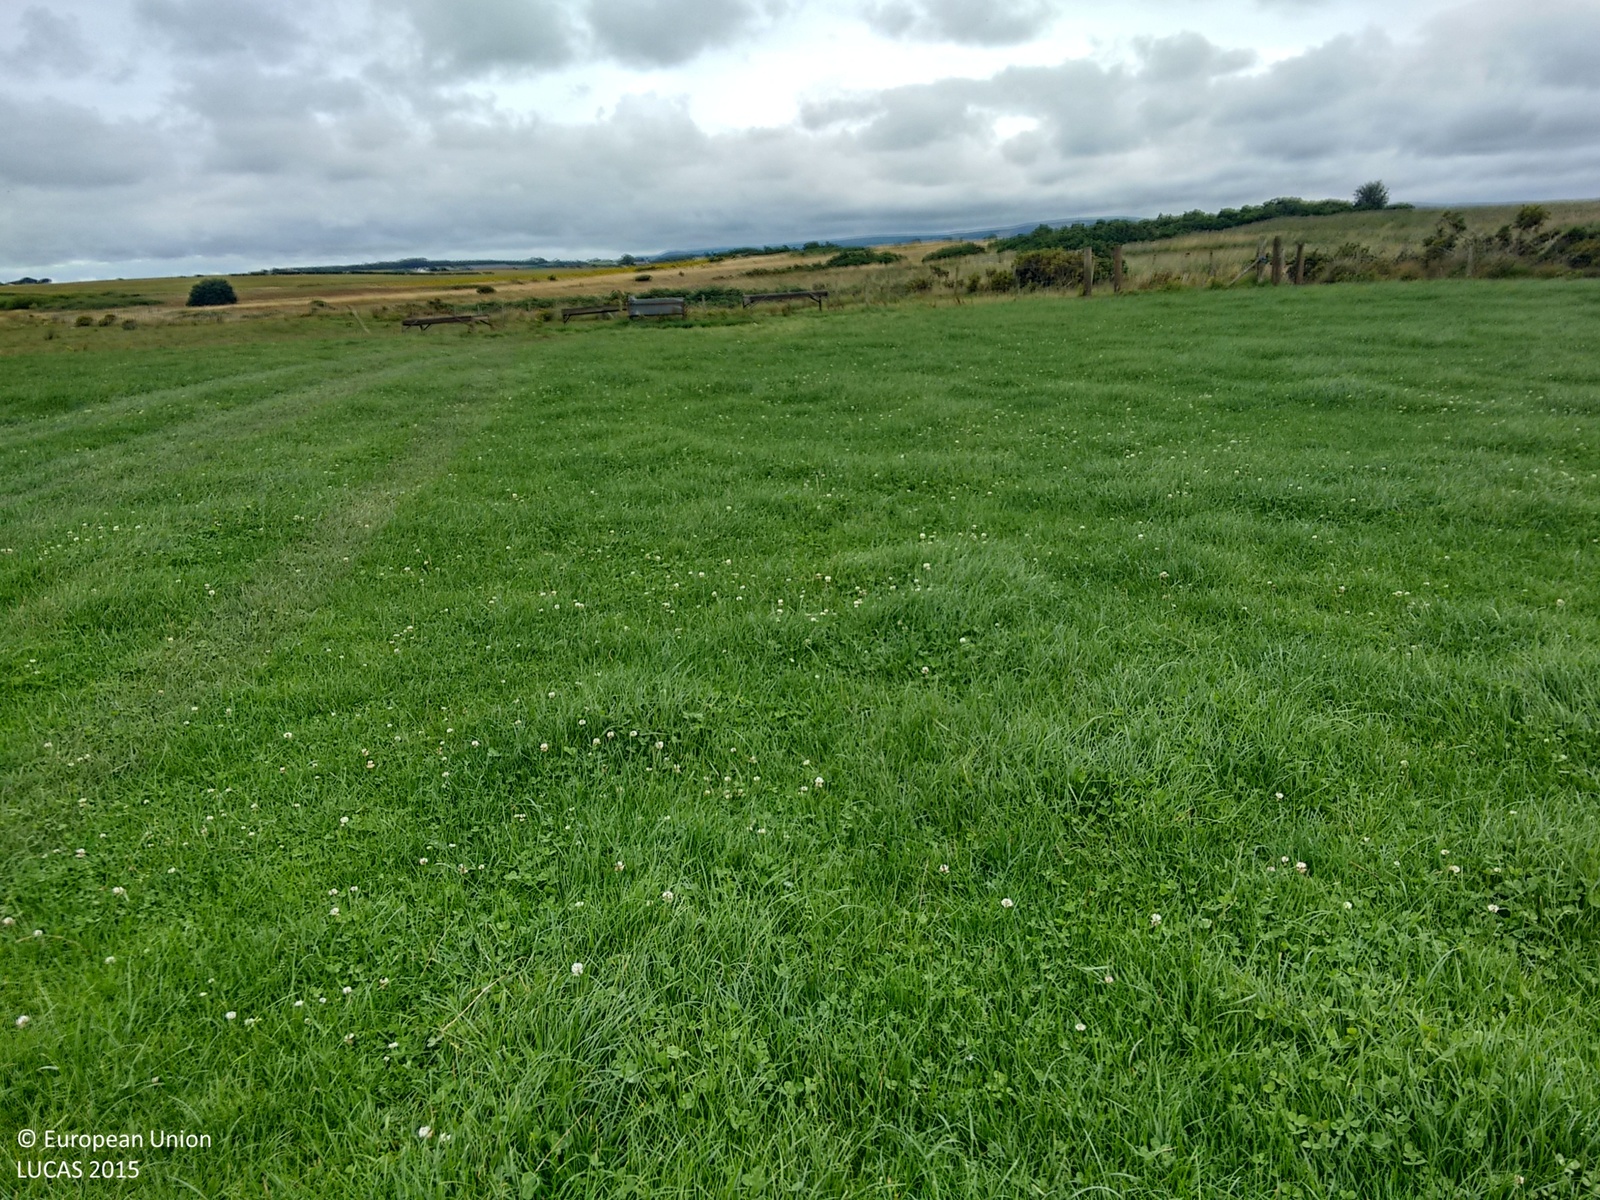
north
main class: Grassland
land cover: Grassland without tree/shrub cover
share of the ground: > 75 %
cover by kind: herbaceous plants 100 %
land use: Agriculture (excluding fallow land and kitchen gardens)
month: August
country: GB
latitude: 54.8462
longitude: -4.9543
